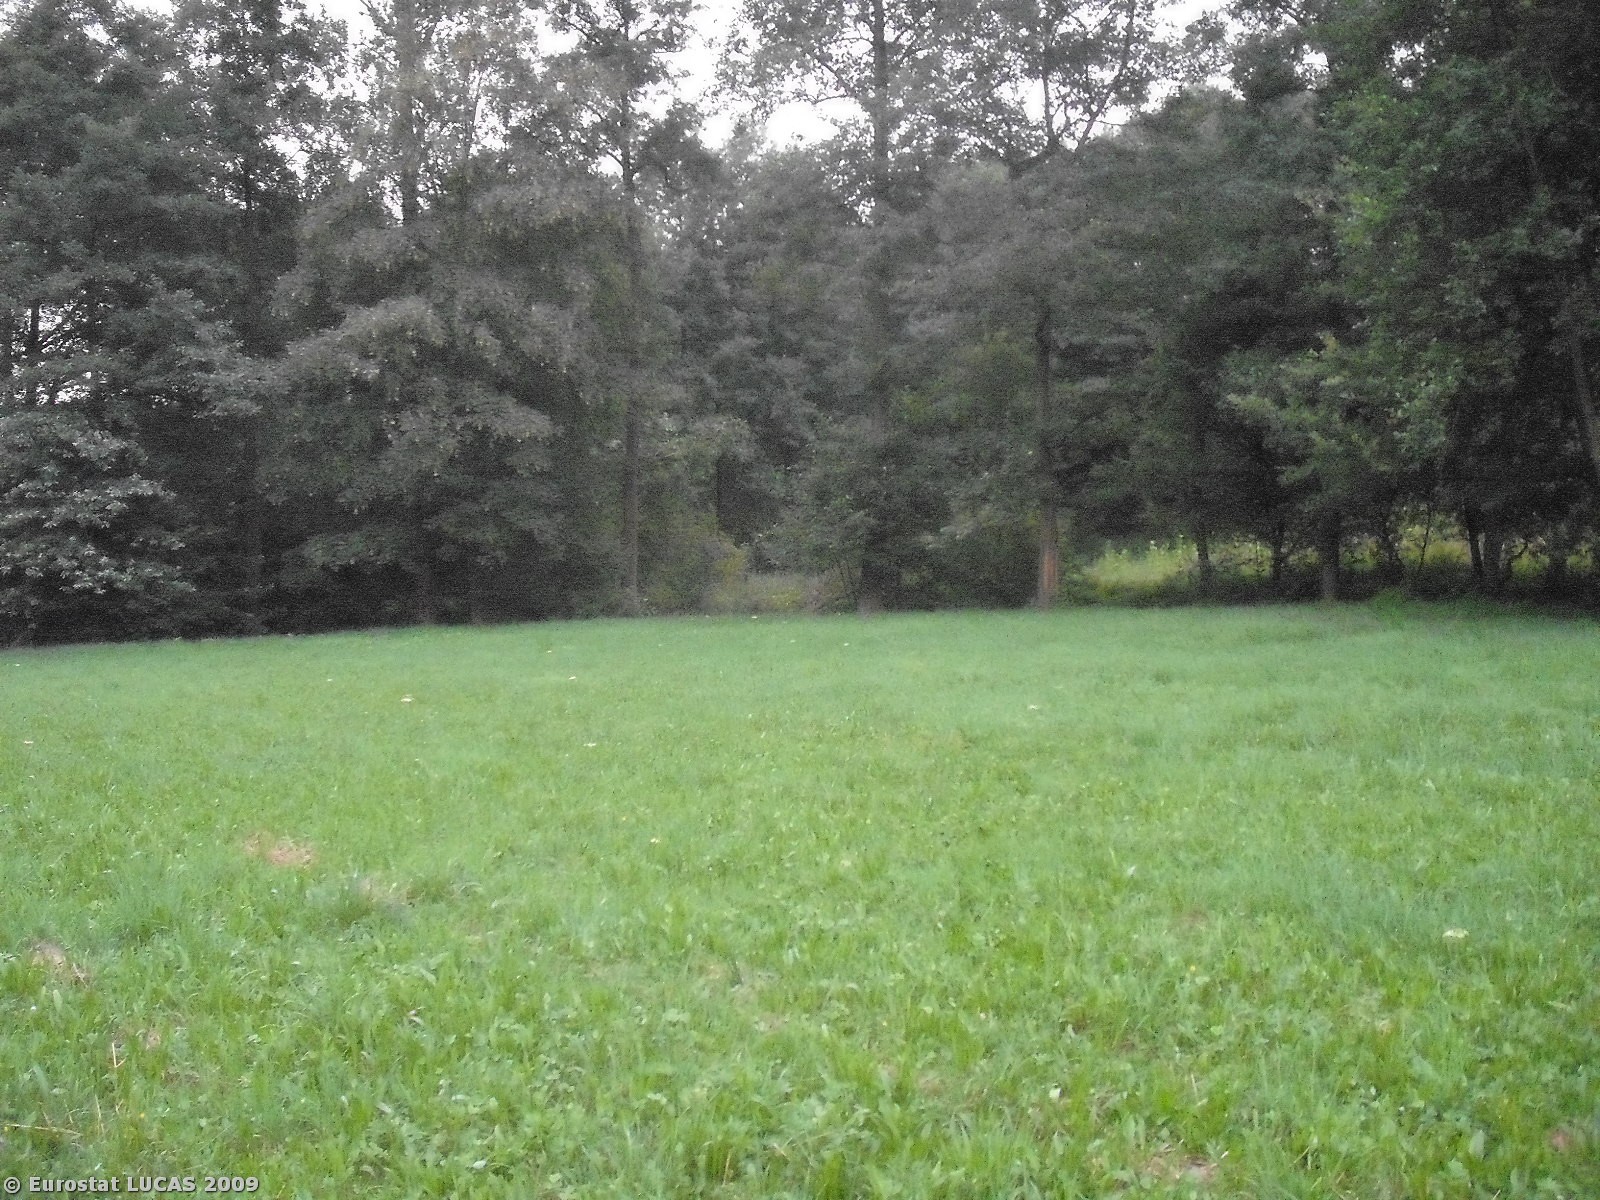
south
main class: Grassland
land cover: Grassland without tree/shrub cover
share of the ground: > 75 %
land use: Agriculture (excluding fallow land and kitchen gardens)
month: August
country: PL
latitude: 49.9876
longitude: 21.0770
